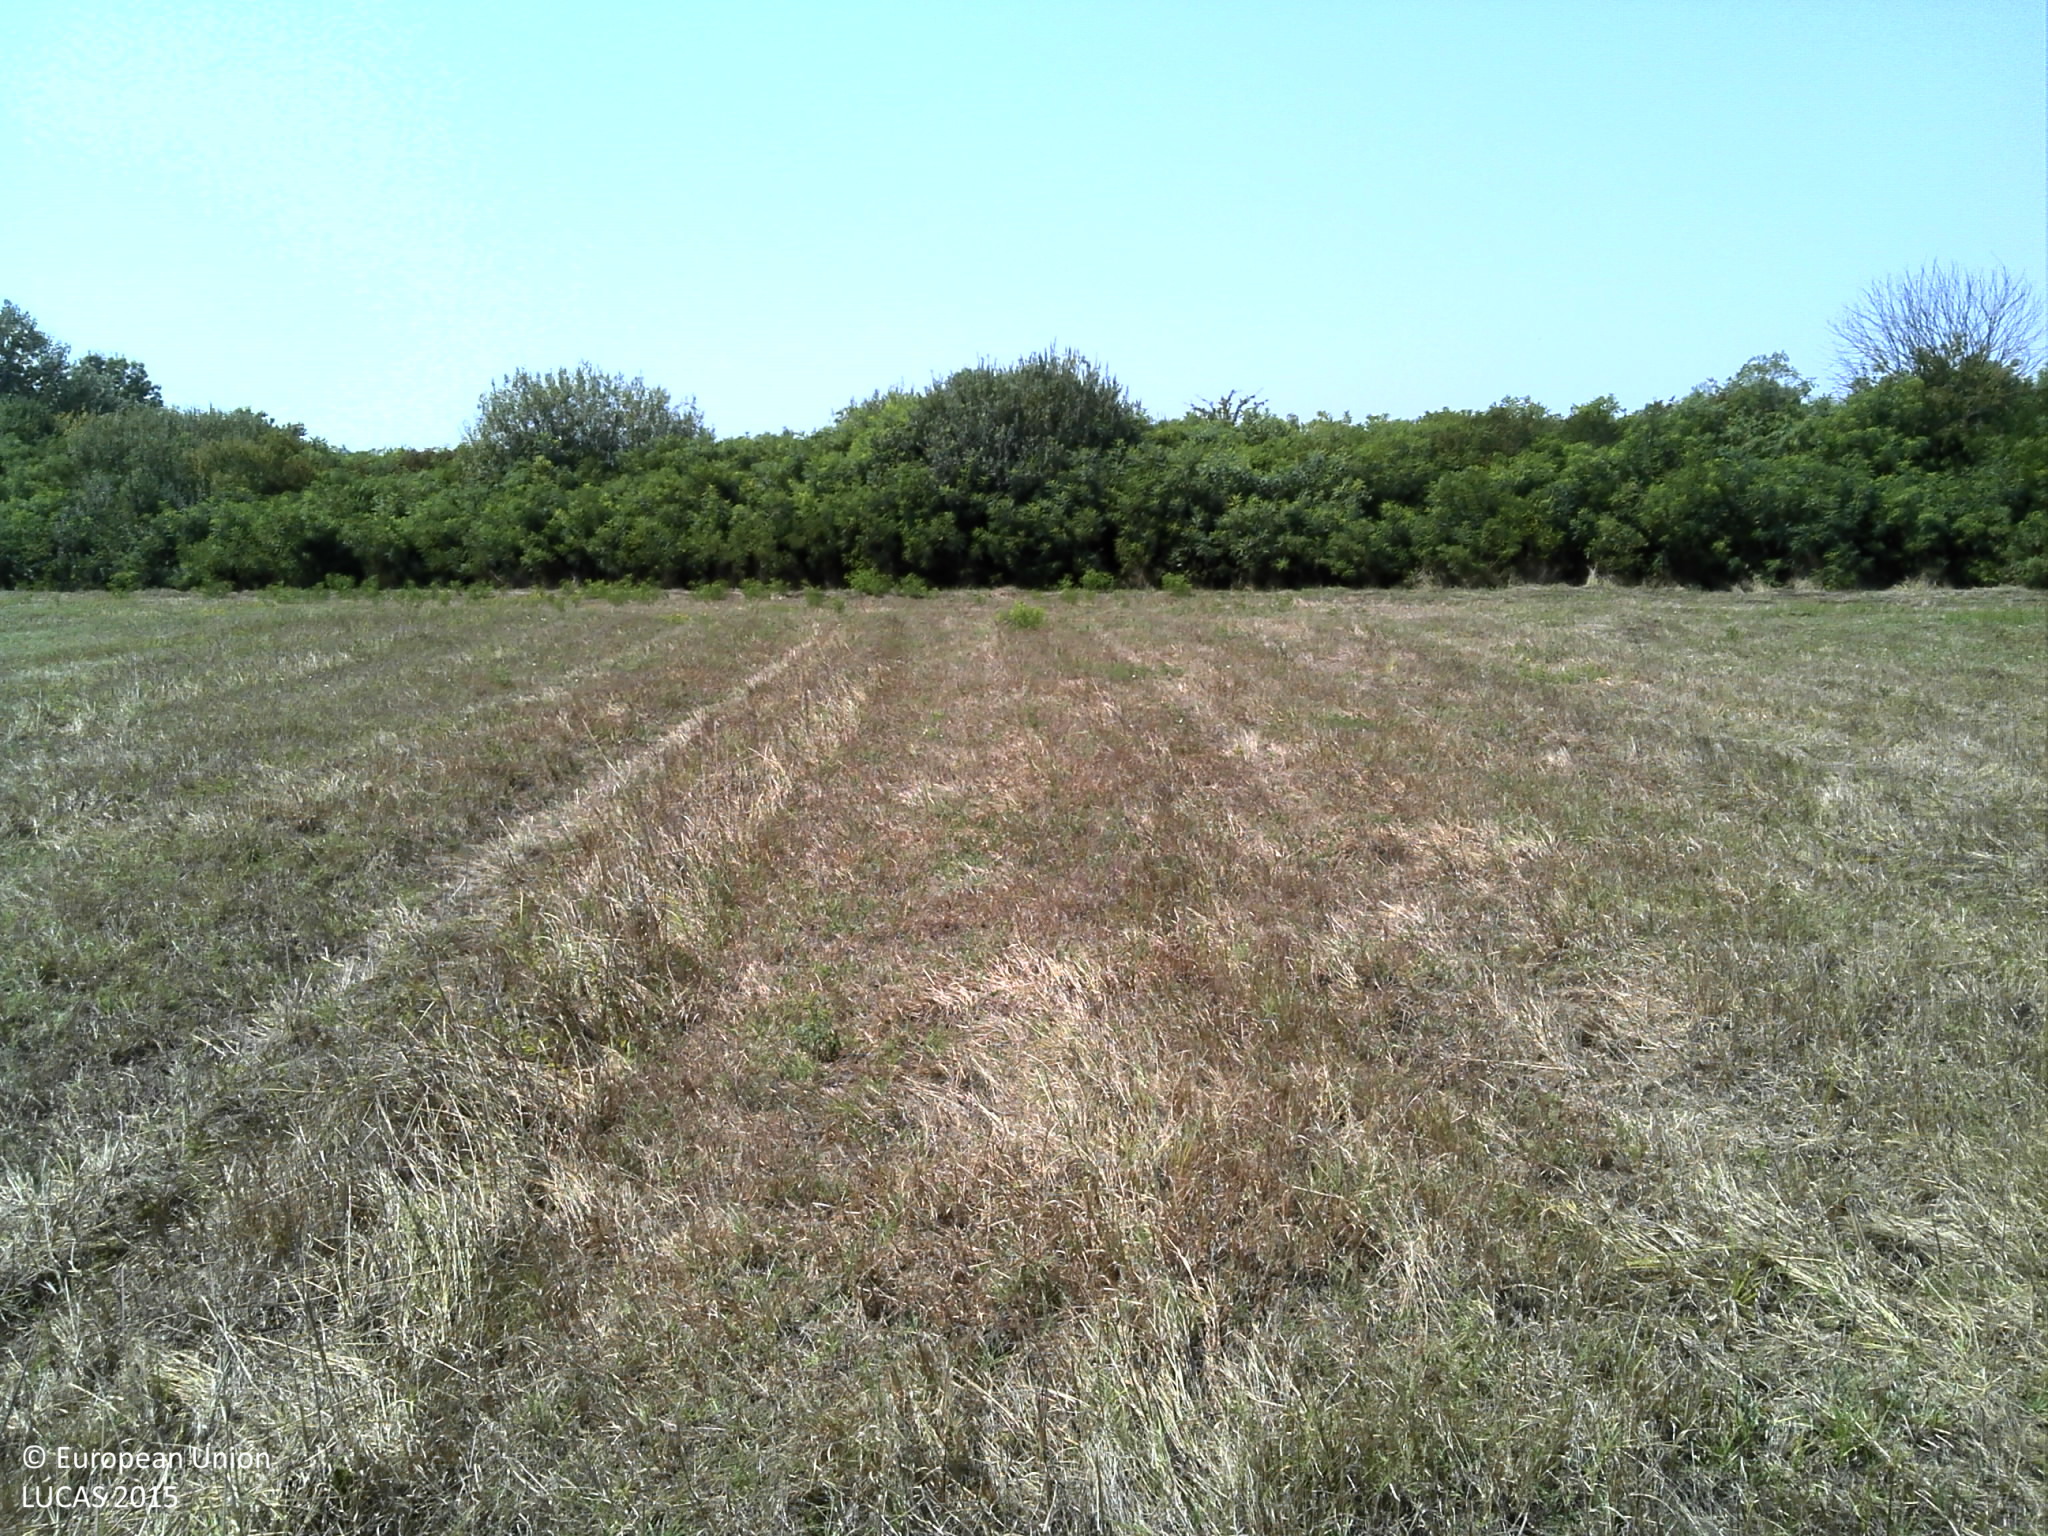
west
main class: Grassland
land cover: Grassland without tree/shrub cover
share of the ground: > 75 %
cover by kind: herbaceous plants 100 %
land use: Agriculture (excluding fallow land and kitchen gardens)
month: August
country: HR
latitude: 45.4950
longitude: 16.3320
